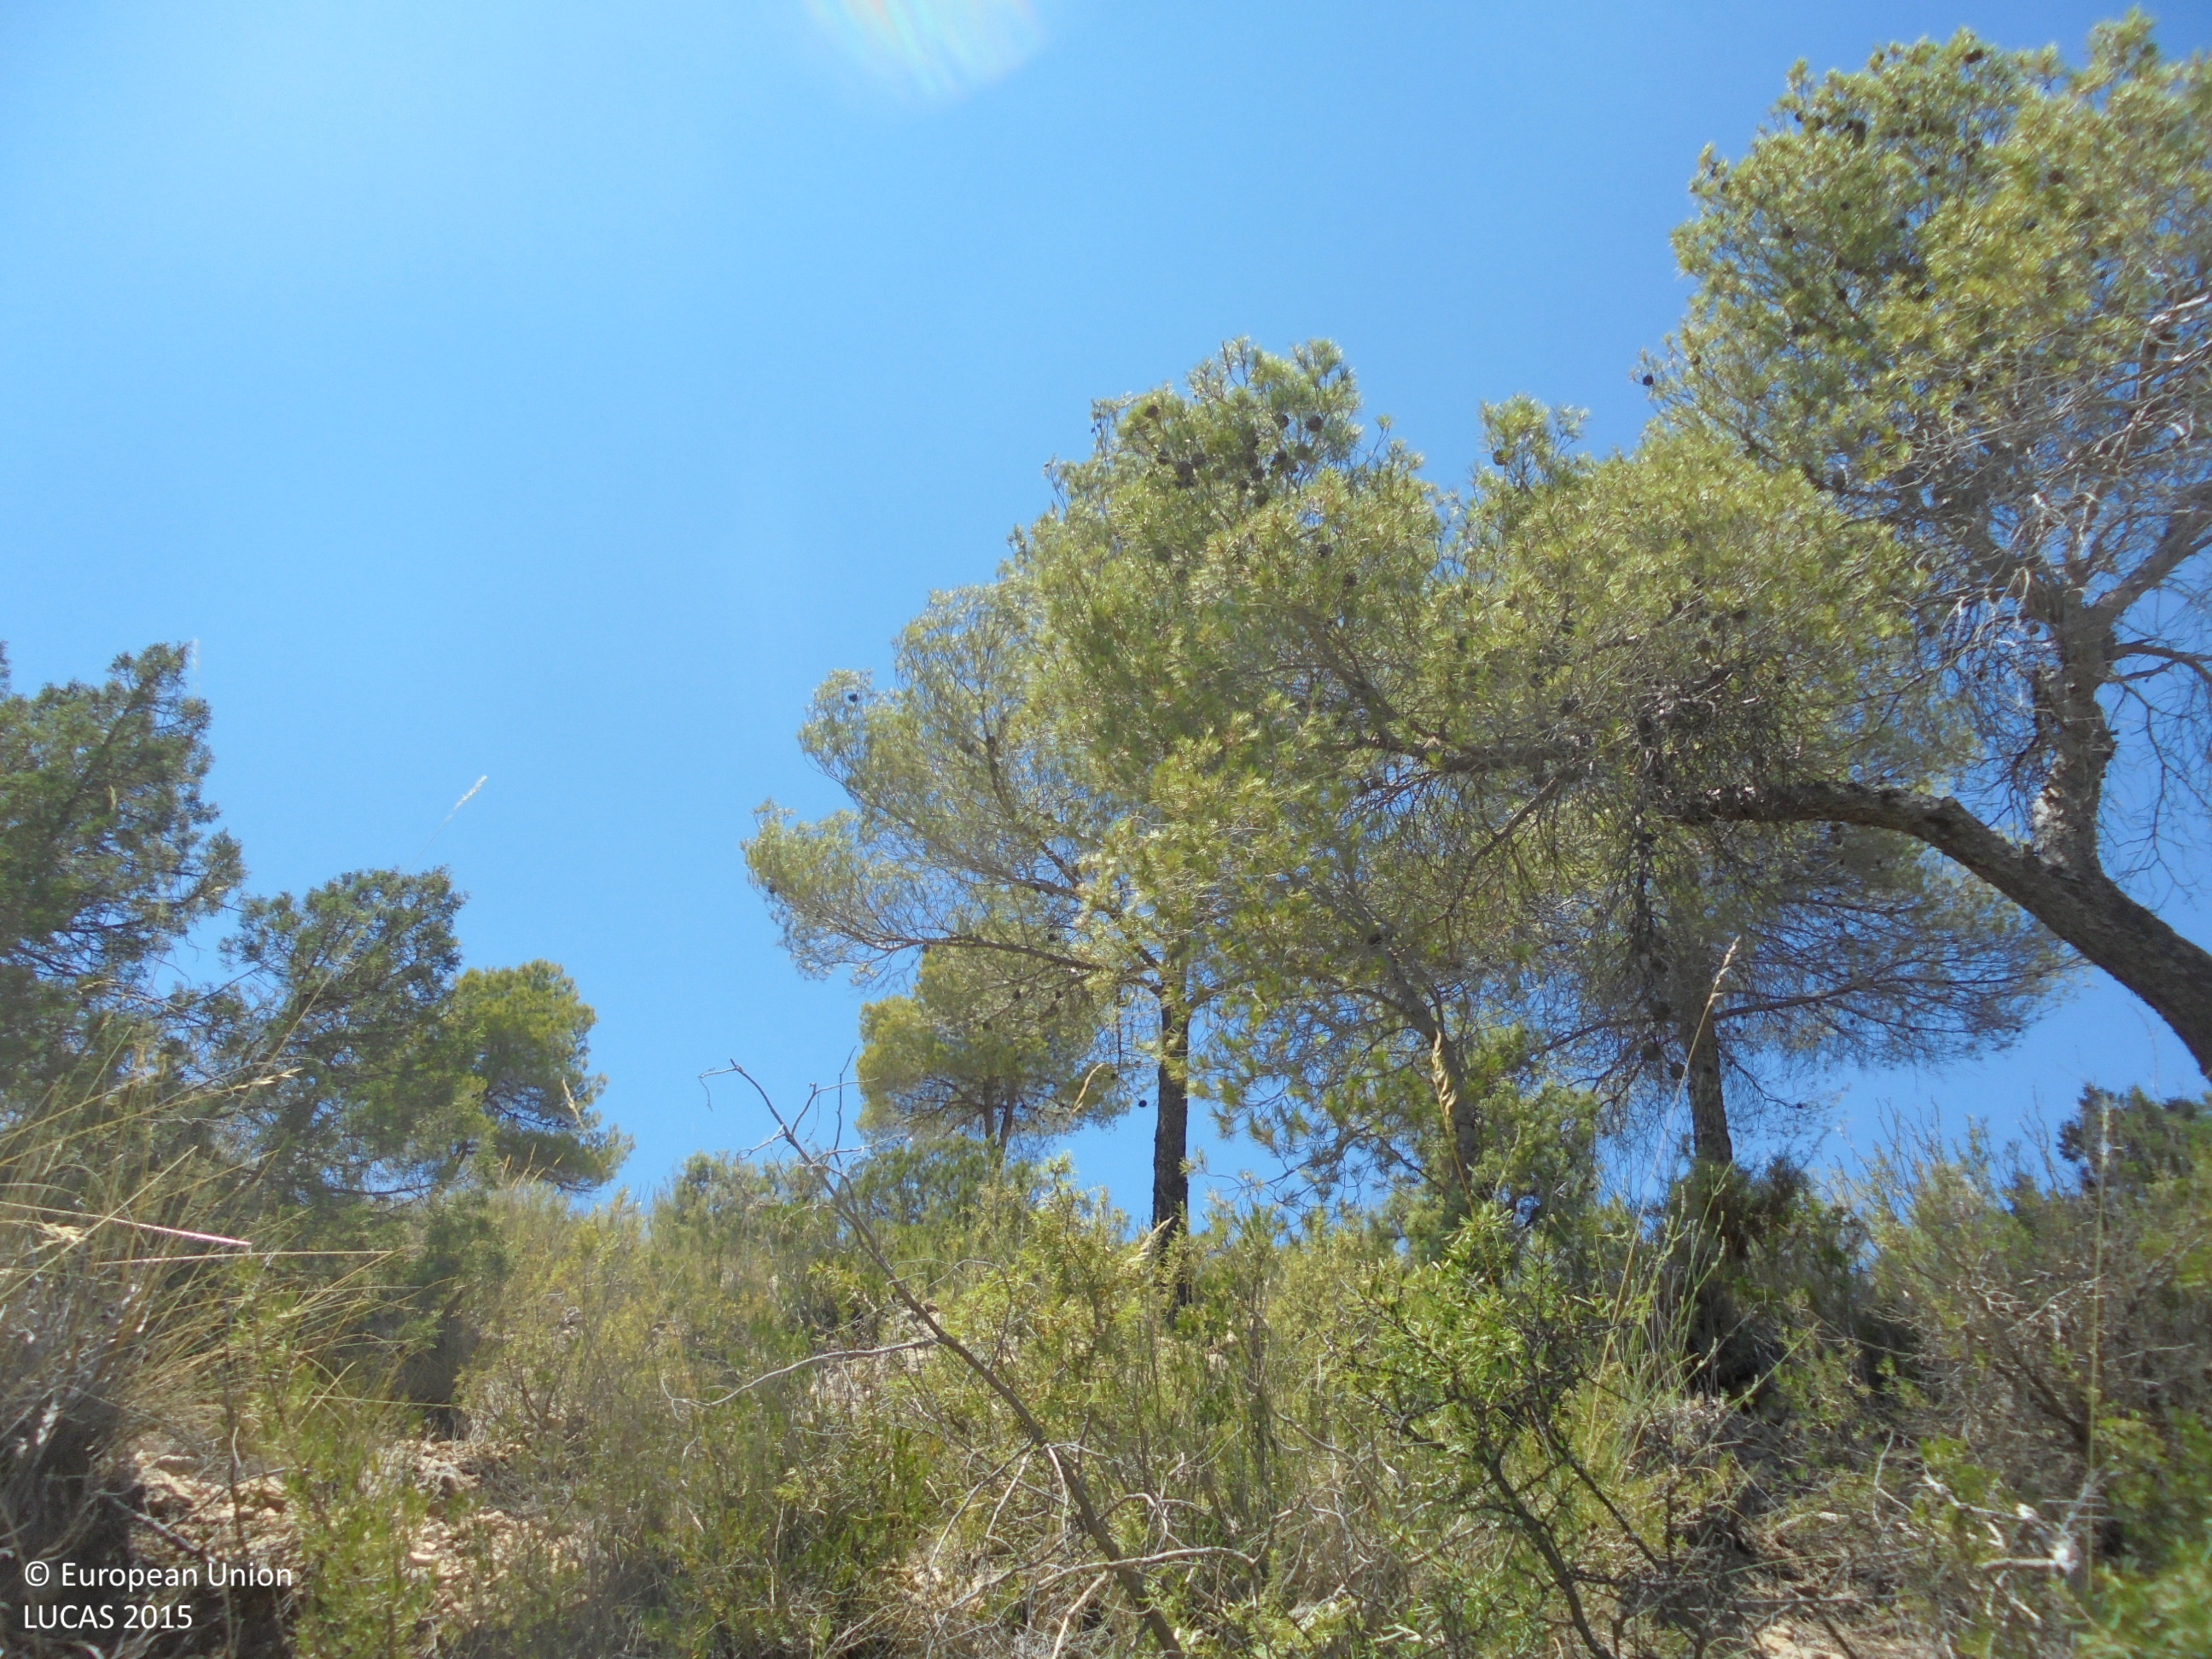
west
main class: Woodland
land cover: Pine dominated coniferous woodland
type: coniferous forest of the mediterranean region
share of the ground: 25 - 50 %
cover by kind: shrubs 50 %, coniferous forest trees 30 %, consolidated bare surface 10 %, unconsolidated bare surface 10 %
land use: Semi-natural and natural areas not in use
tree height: > 5 m
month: July
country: ES
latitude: 38.9669
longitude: -1.0400
